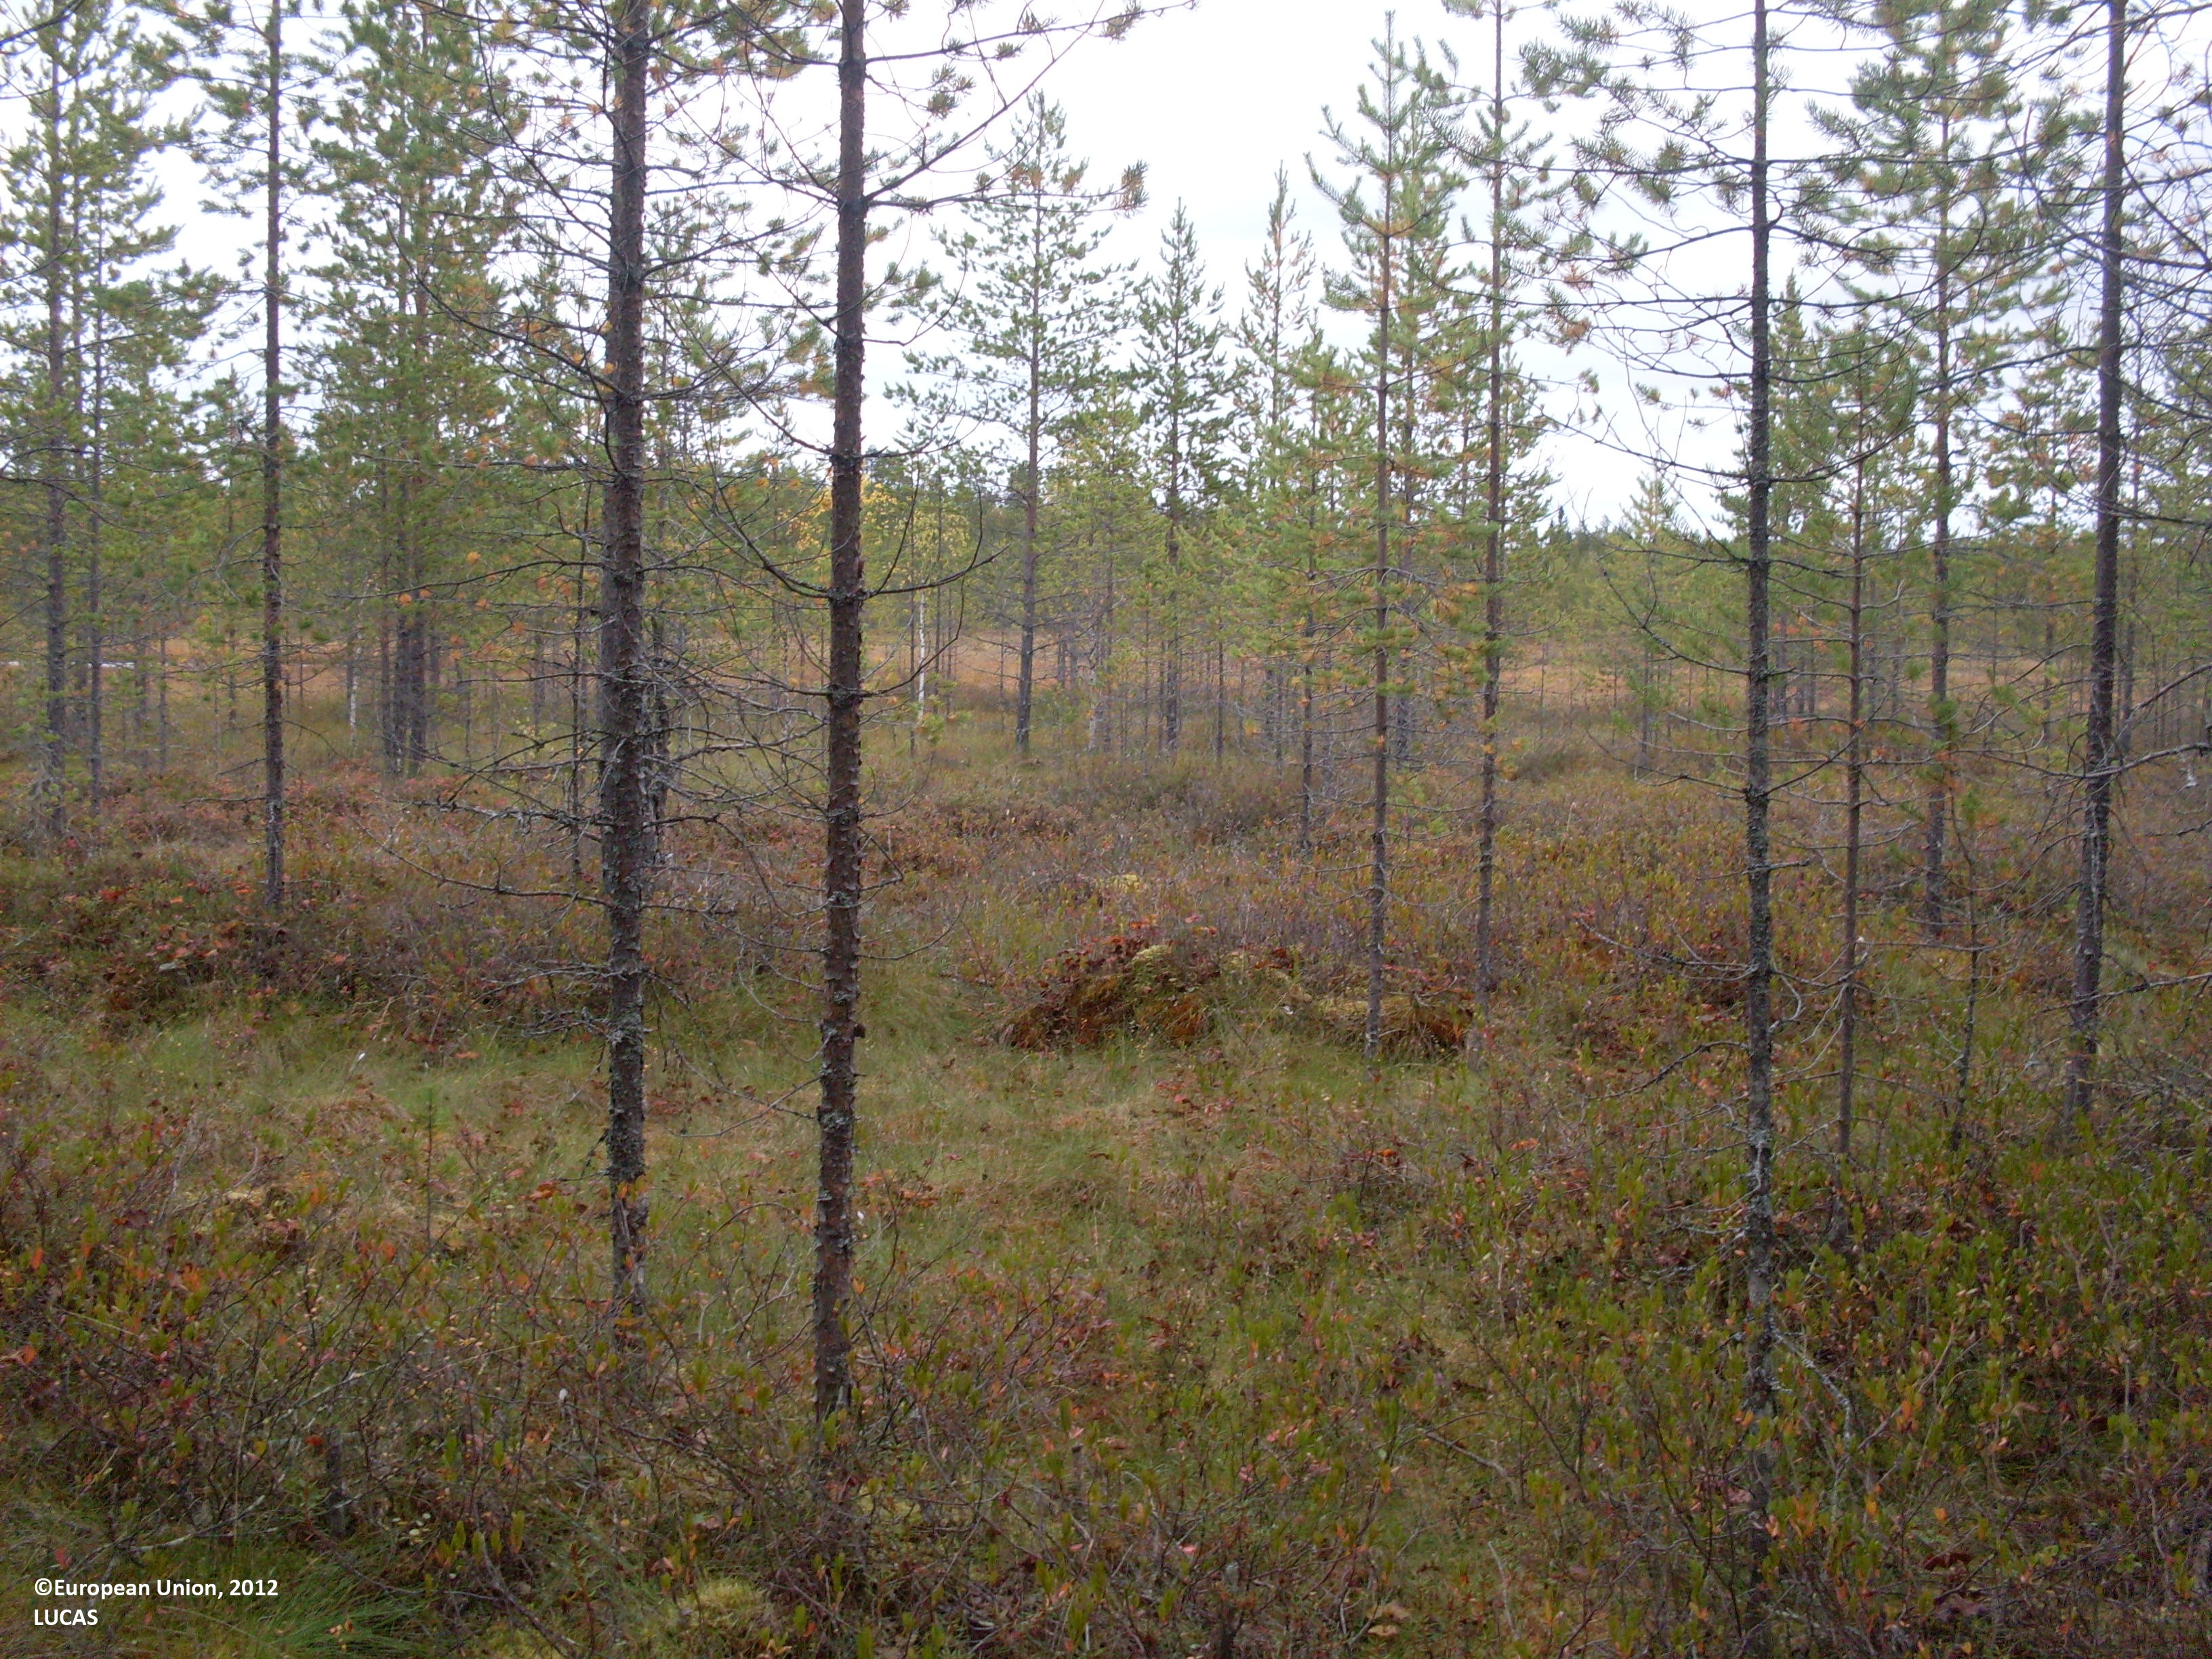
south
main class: Woodland
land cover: Pine dominated coniferous woodland
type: boreal forest
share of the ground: 50 - 75 %
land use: Forestry
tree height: > 5 m
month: September
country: FI
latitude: 64.1504
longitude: 29.4360
